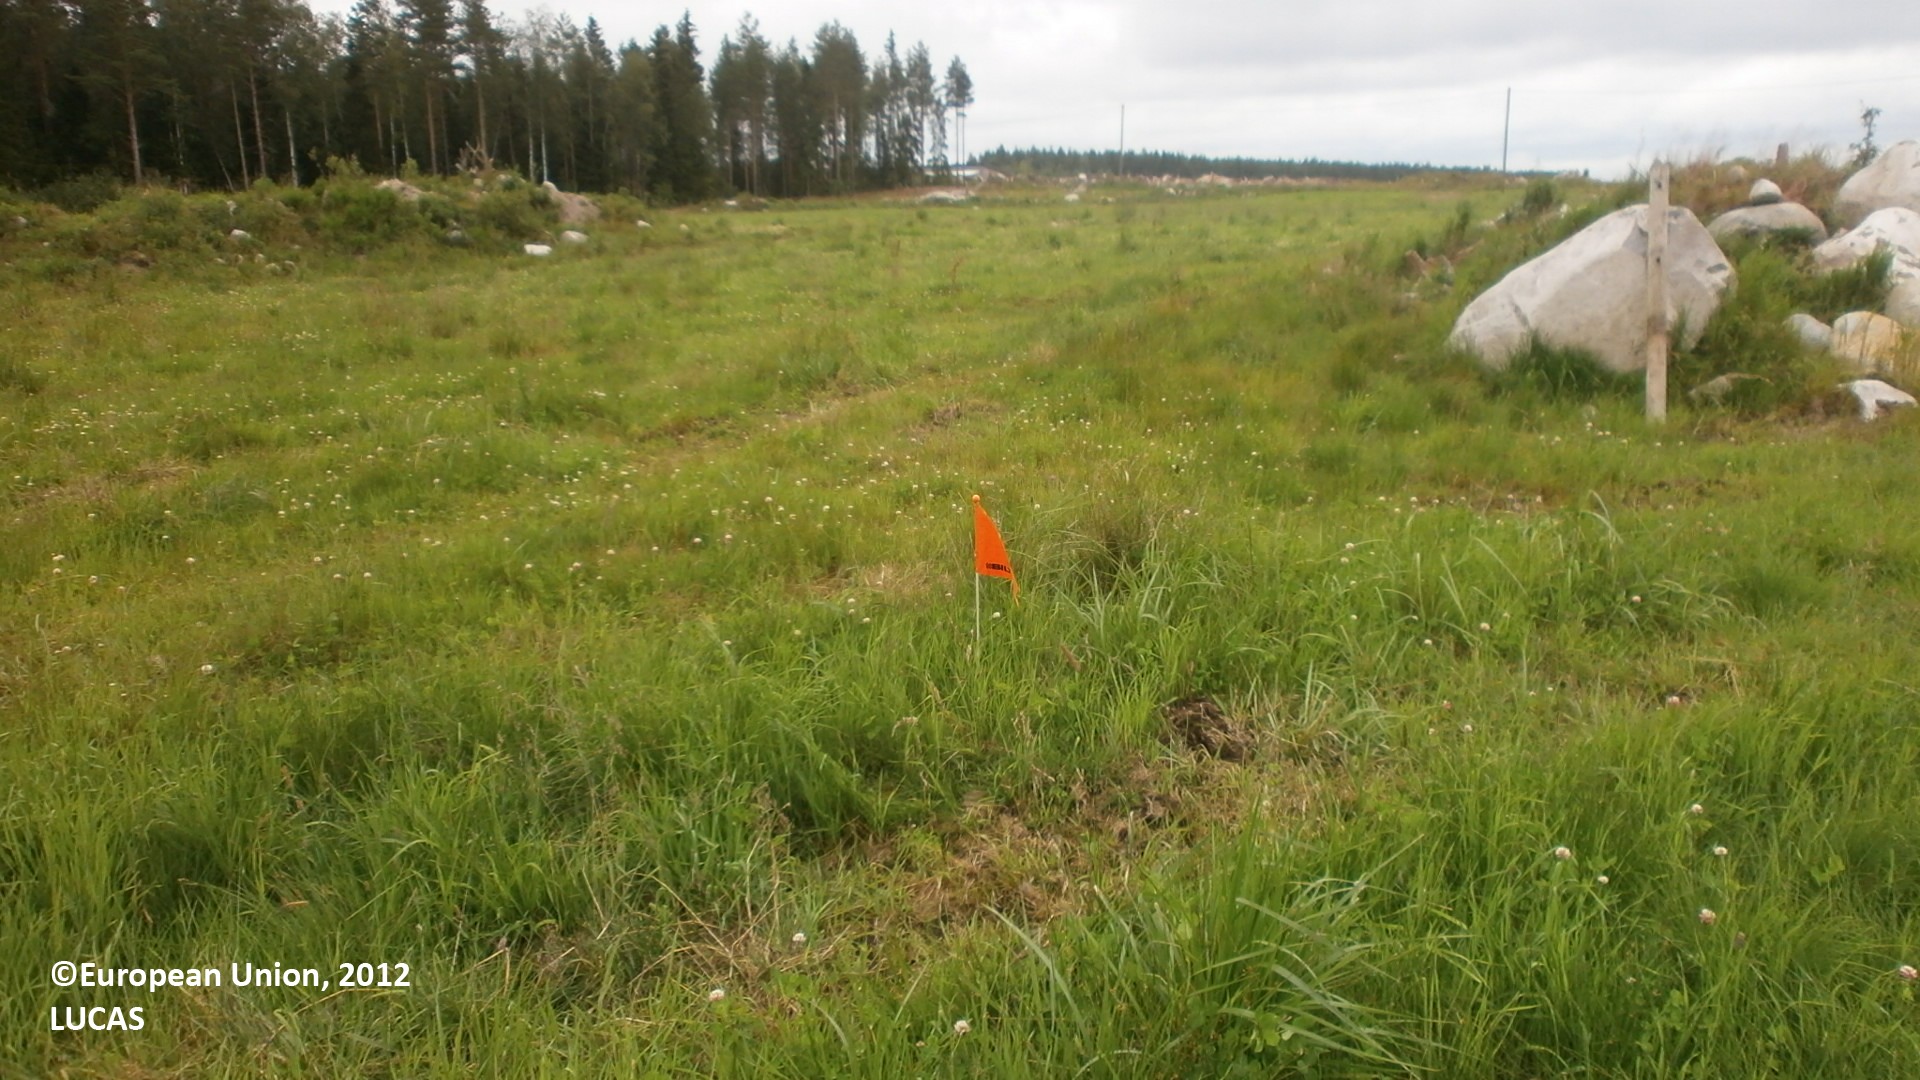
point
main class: Grassland
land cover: Grassland without tree/shrub cover
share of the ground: 50 - 75 %
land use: Agriculture (excluding fallow land and kitchen gardens)
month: July
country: FI
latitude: 64.2070
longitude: 24.0923
